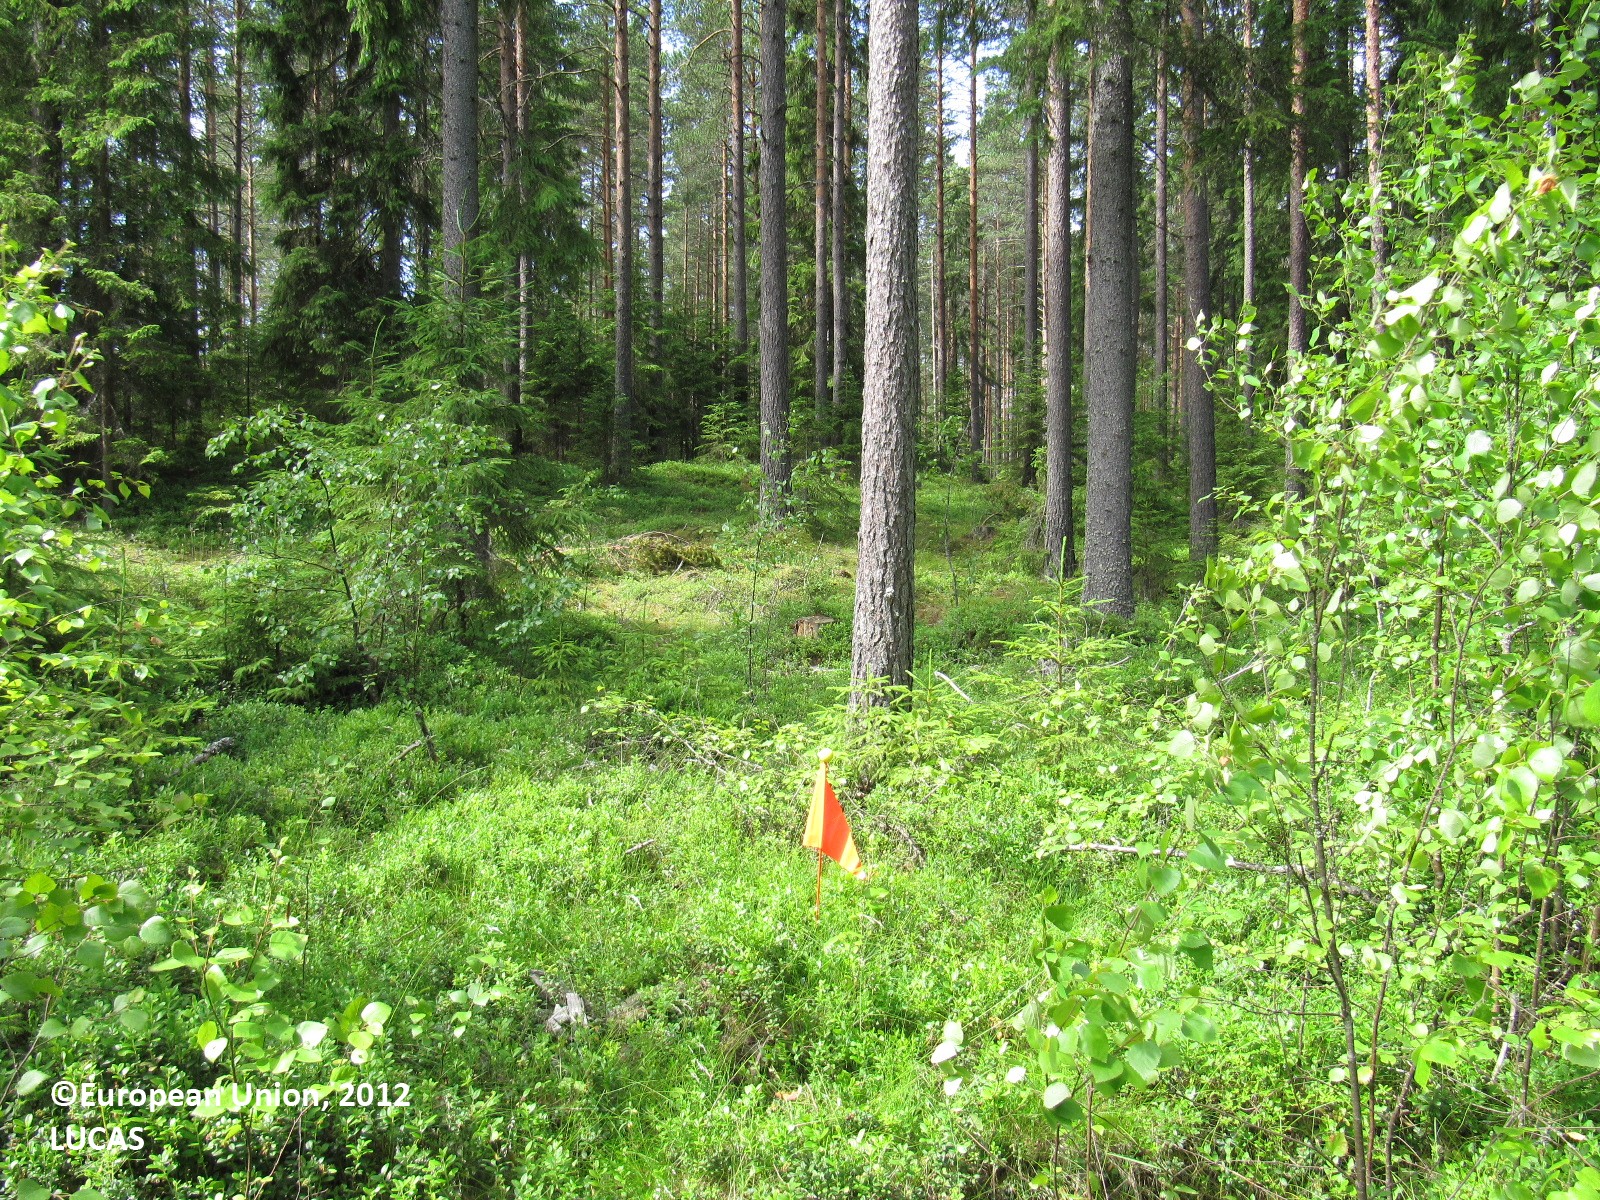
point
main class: Woodland
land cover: Other coniferous woodland
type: boreal forest
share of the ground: > 75 %
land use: Forestry
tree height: > 5 m
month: July
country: FI
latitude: 60.9864
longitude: 23.3702
